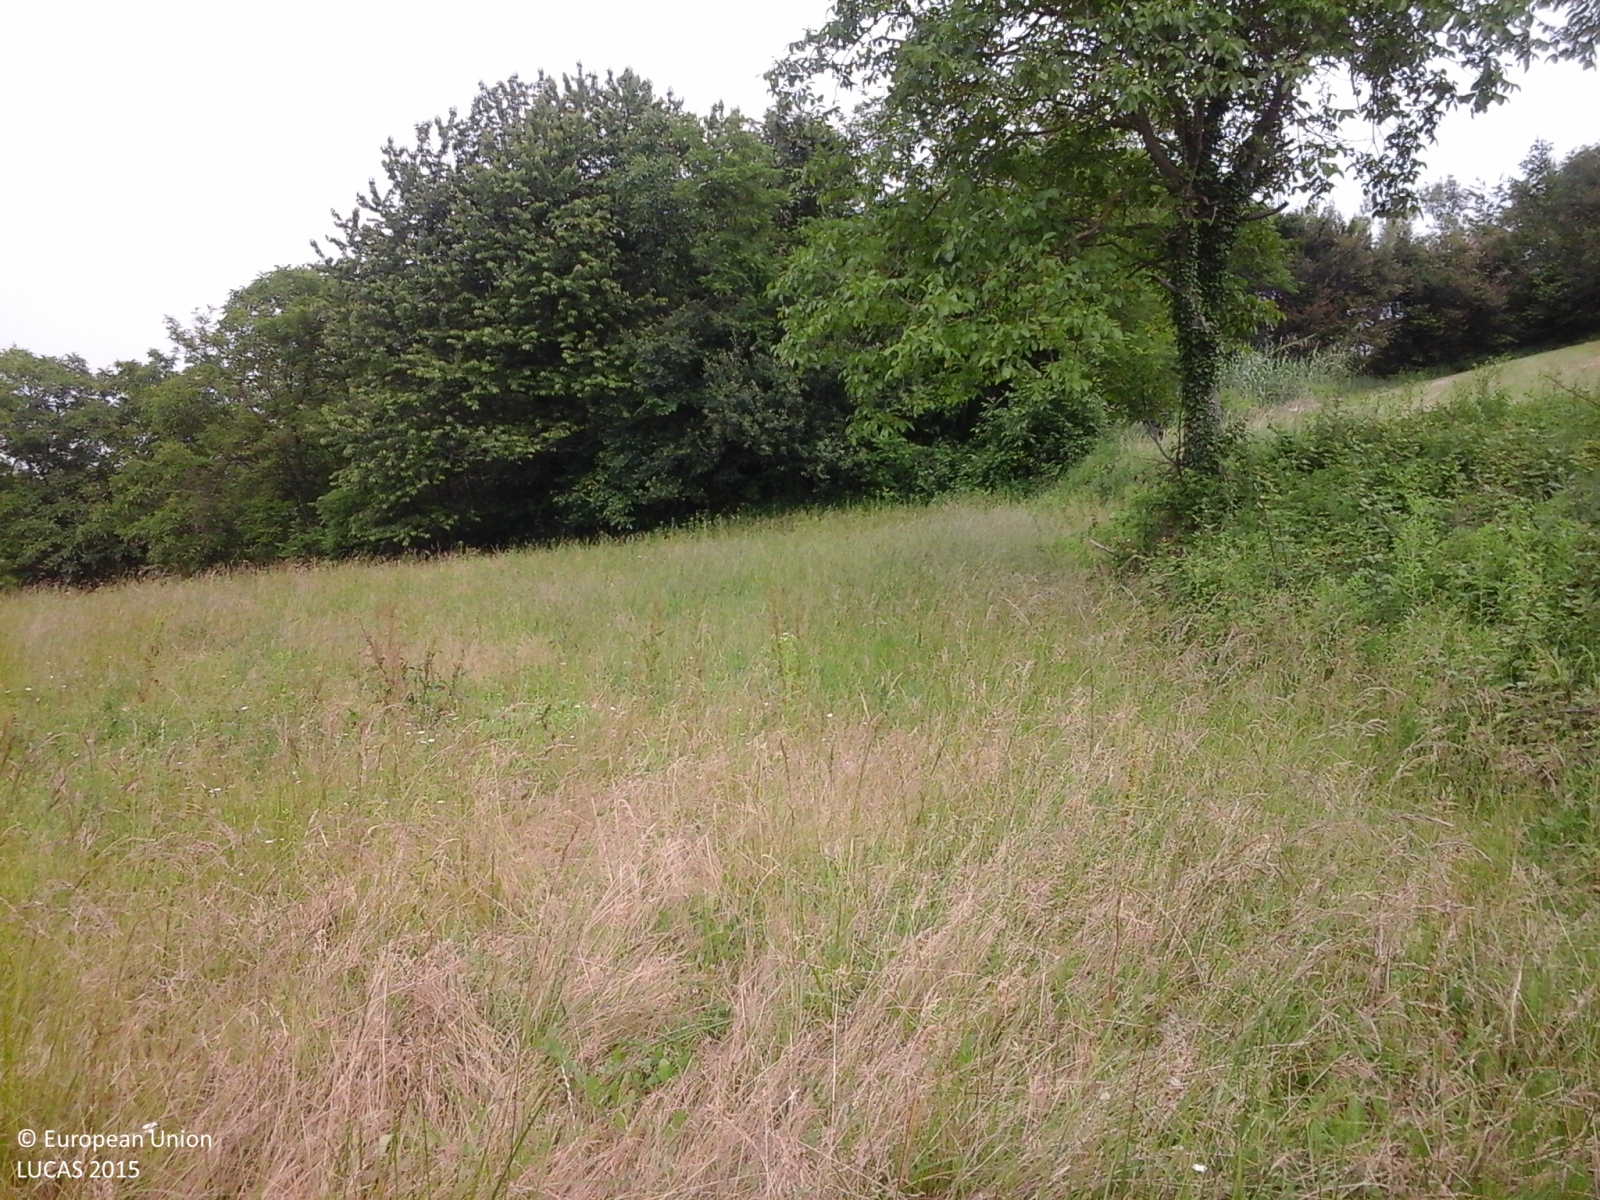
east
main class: Grassland
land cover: Grassland without tree/shrub cover
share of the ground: > 75 %
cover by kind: herbaceous plants 100 %
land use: Agriculture (excluding fallow land and kitchen gardens)
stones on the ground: 10 - 25 %
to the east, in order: Grassland without tree/shrub cover; Broadleaved woodland; Grassland without tree/shrub cover; Broadleaved woodland
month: May
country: IT
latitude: 45.1089
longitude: 8.1096
